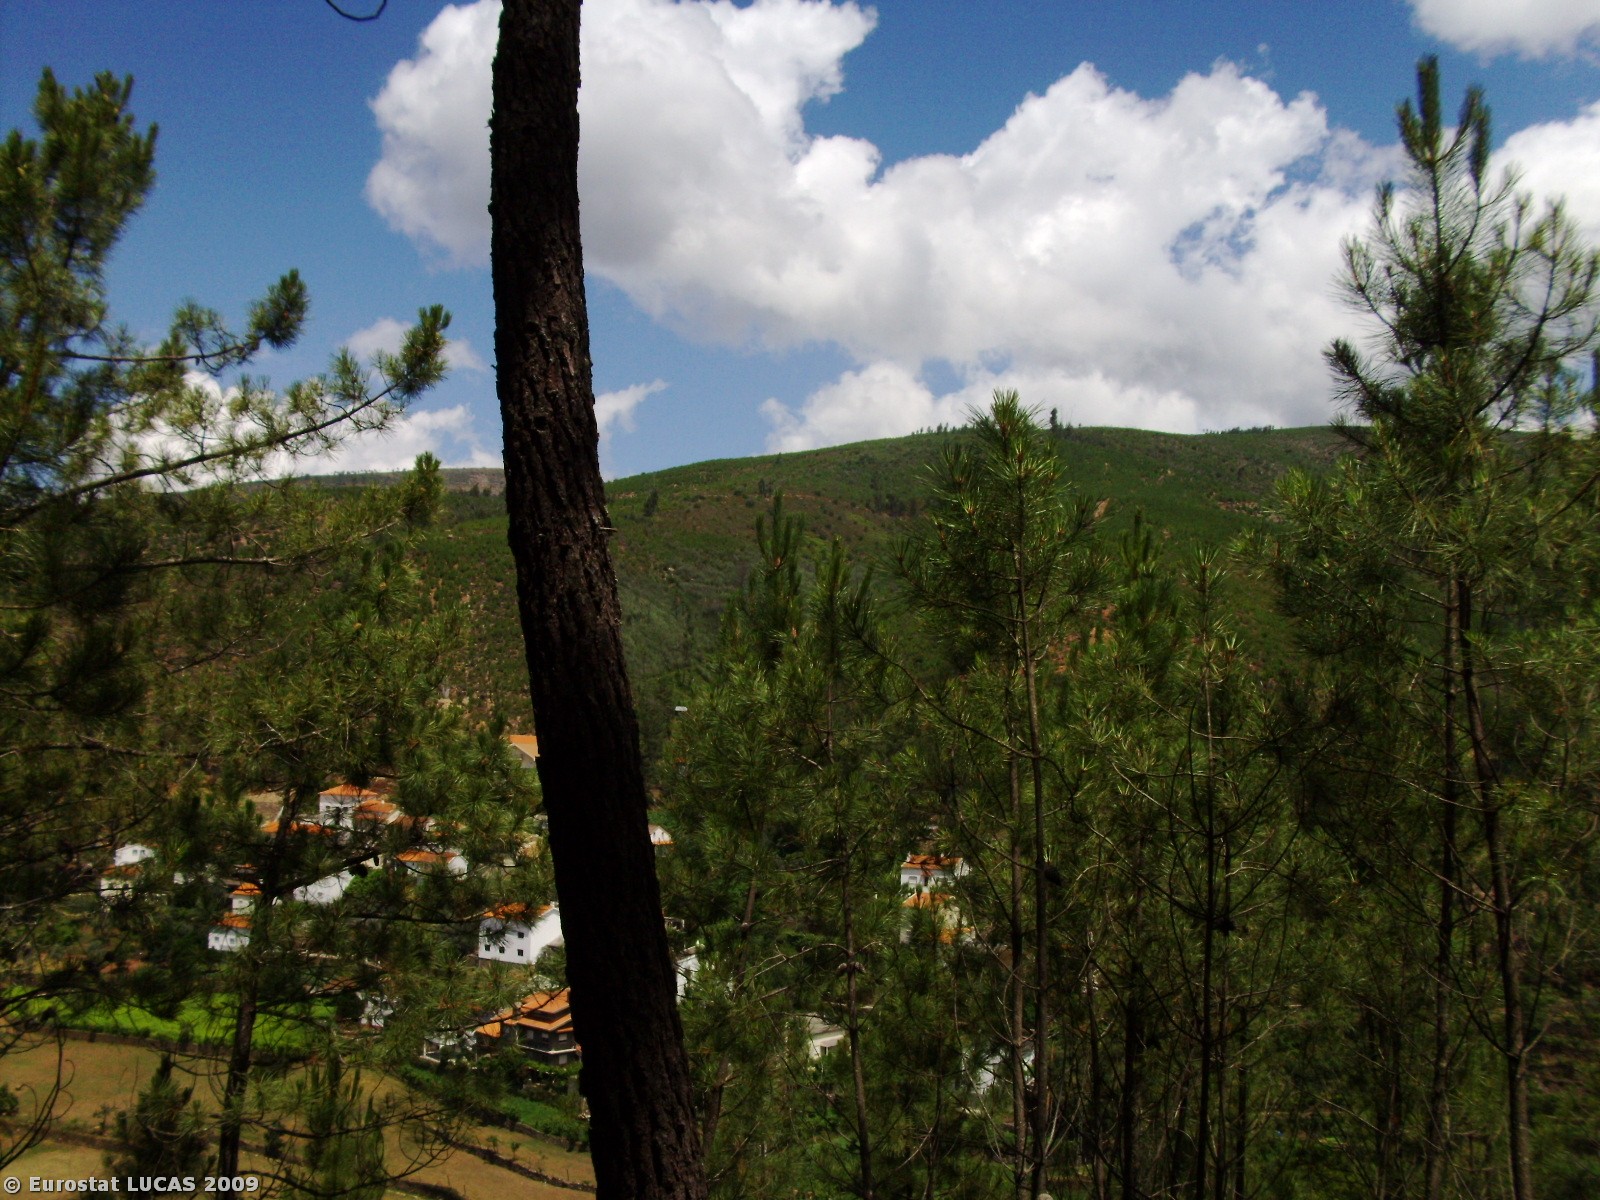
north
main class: Woodland
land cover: Coniferous woodland
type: coniferous forest of the mediterranean region
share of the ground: > 75 %
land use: Forestry
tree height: > 5 m
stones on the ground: 25 - 50 %
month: June
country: PT
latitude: 40.2832
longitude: -7.7206
